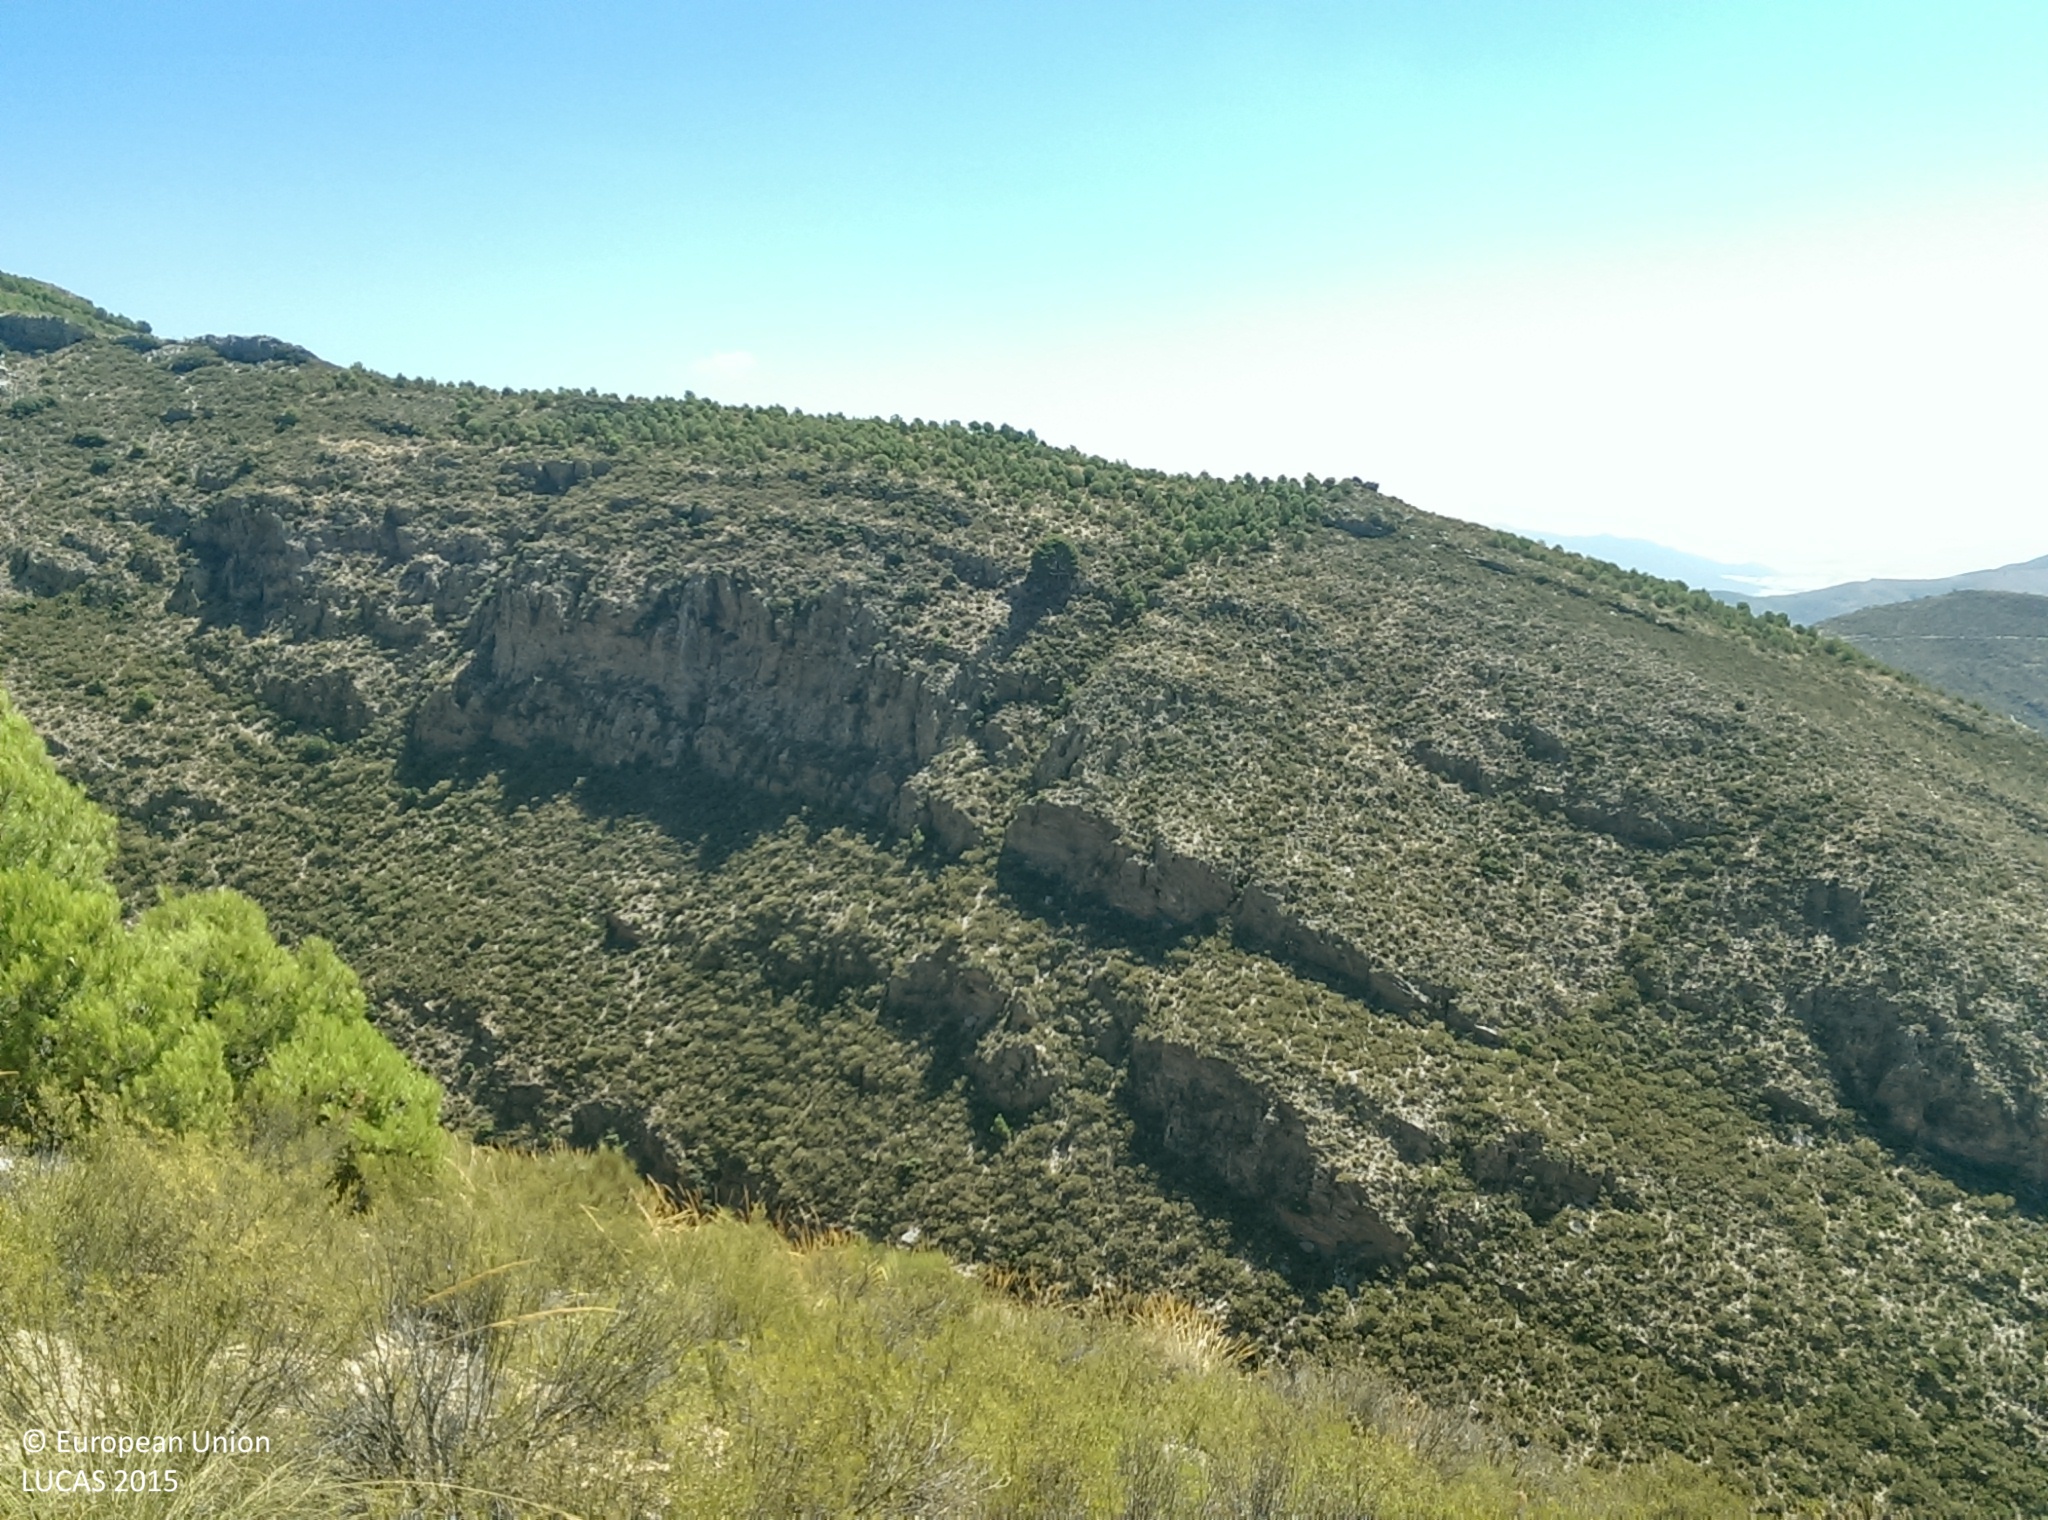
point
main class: Shrubland
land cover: Shrubland without tree cover
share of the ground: 50 - 75 %
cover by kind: shrubs 60 %, herbaceous plants 20 %, unconsolidated bare surface 20 %
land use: Semi-natural and natural areas not in use
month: August
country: ES
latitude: 36.8178
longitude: -3.1065
